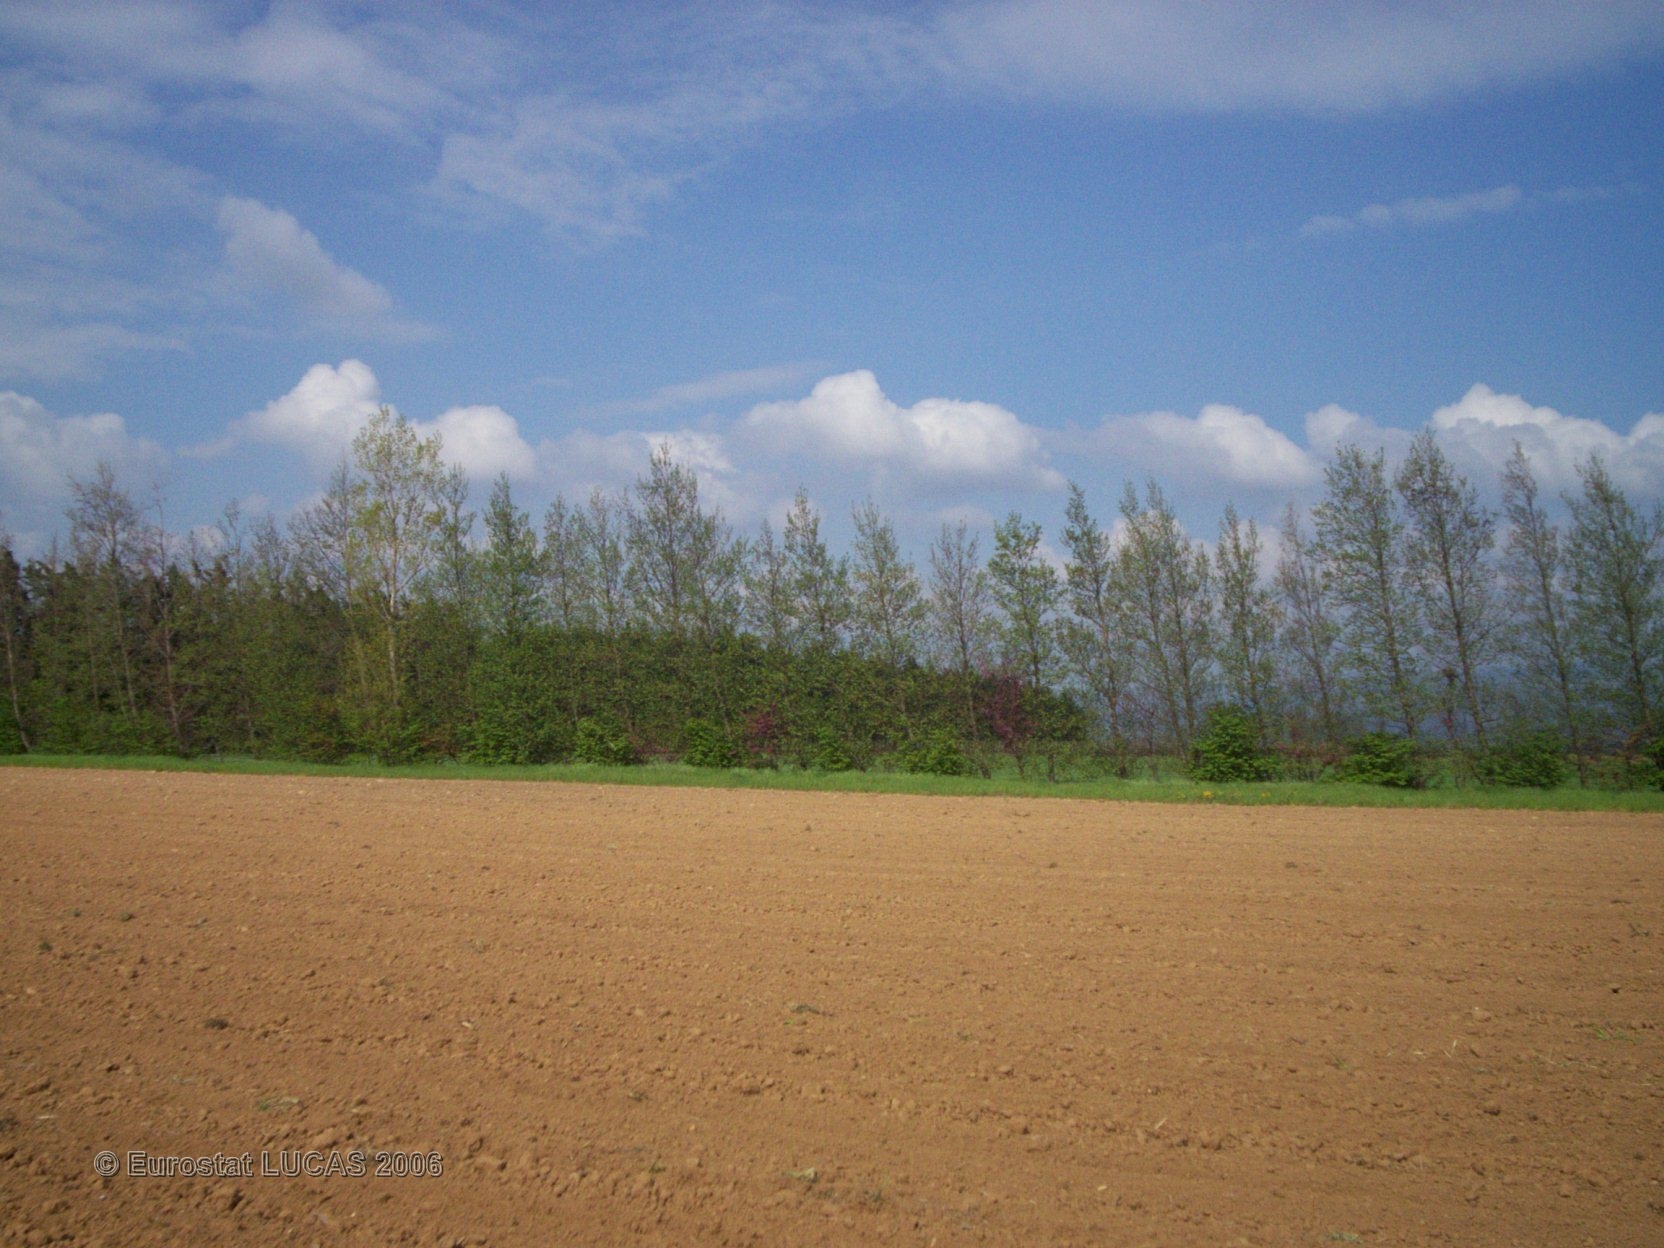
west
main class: Cropland
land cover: Maize
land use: Agriculture (excluding fallow land and kitchen gardens)
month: June
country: FR
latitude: 44.8026
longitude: 4.8859
